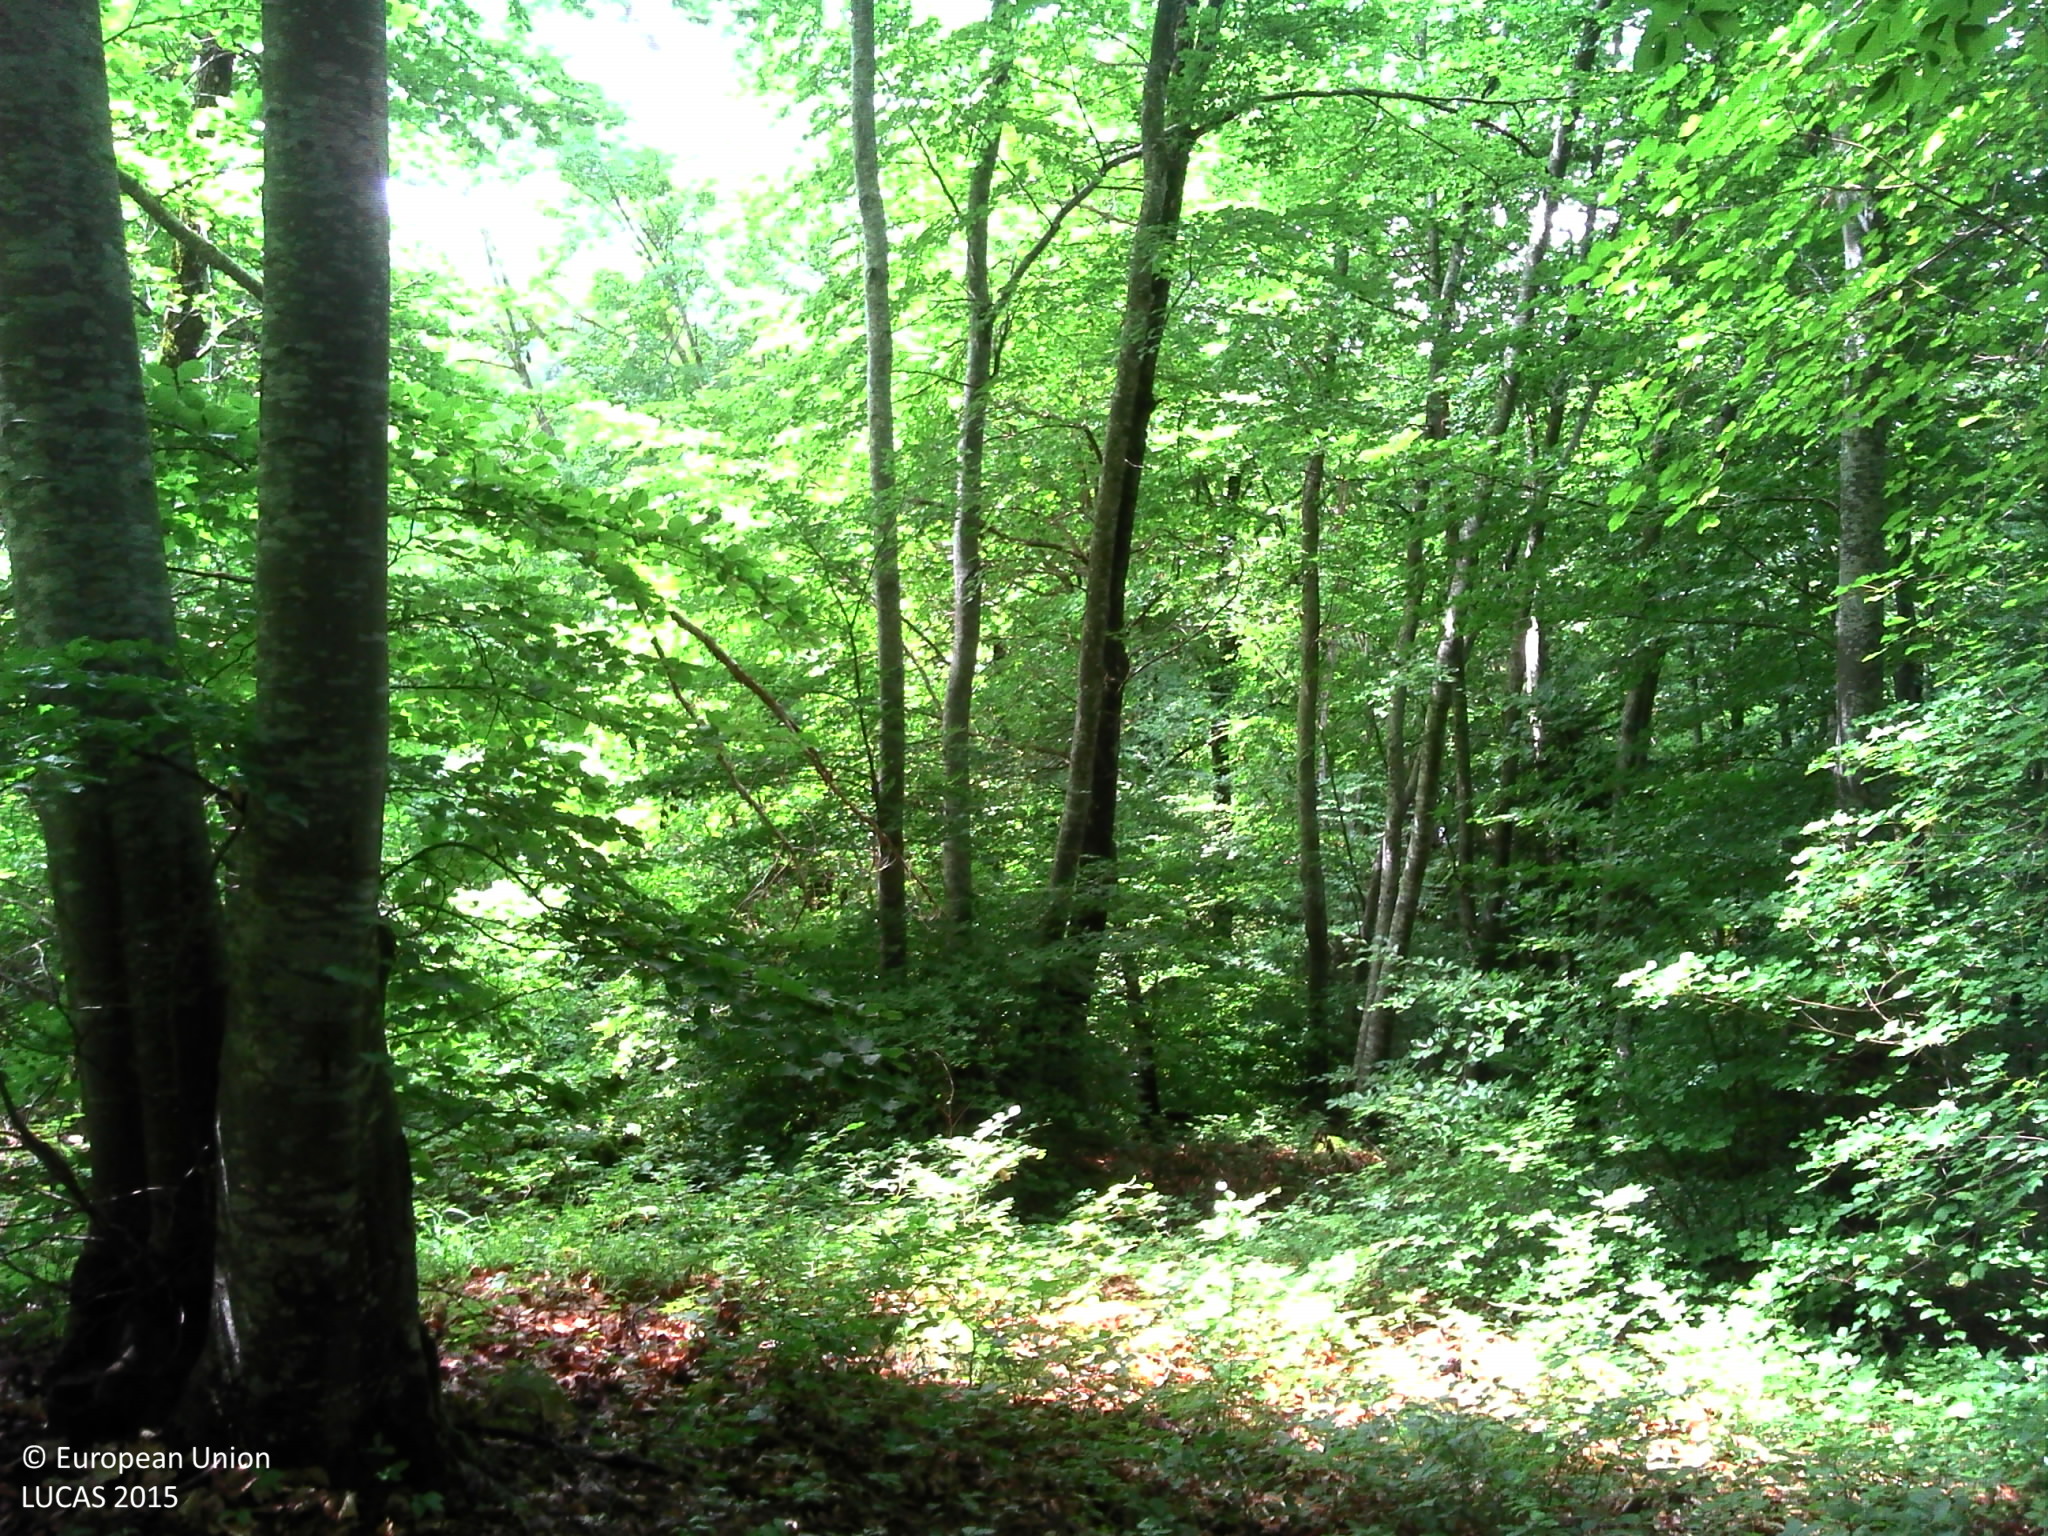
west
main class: Woodland
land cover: Broadleaved woodland
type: beech forest
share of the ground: > 75 %
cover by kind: broadleaved forest trees 95 %, lichens and mosses 5 %
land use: Forestry
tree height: > 5 m
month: June
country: FR
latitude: 44.6696
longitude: 5.1251
